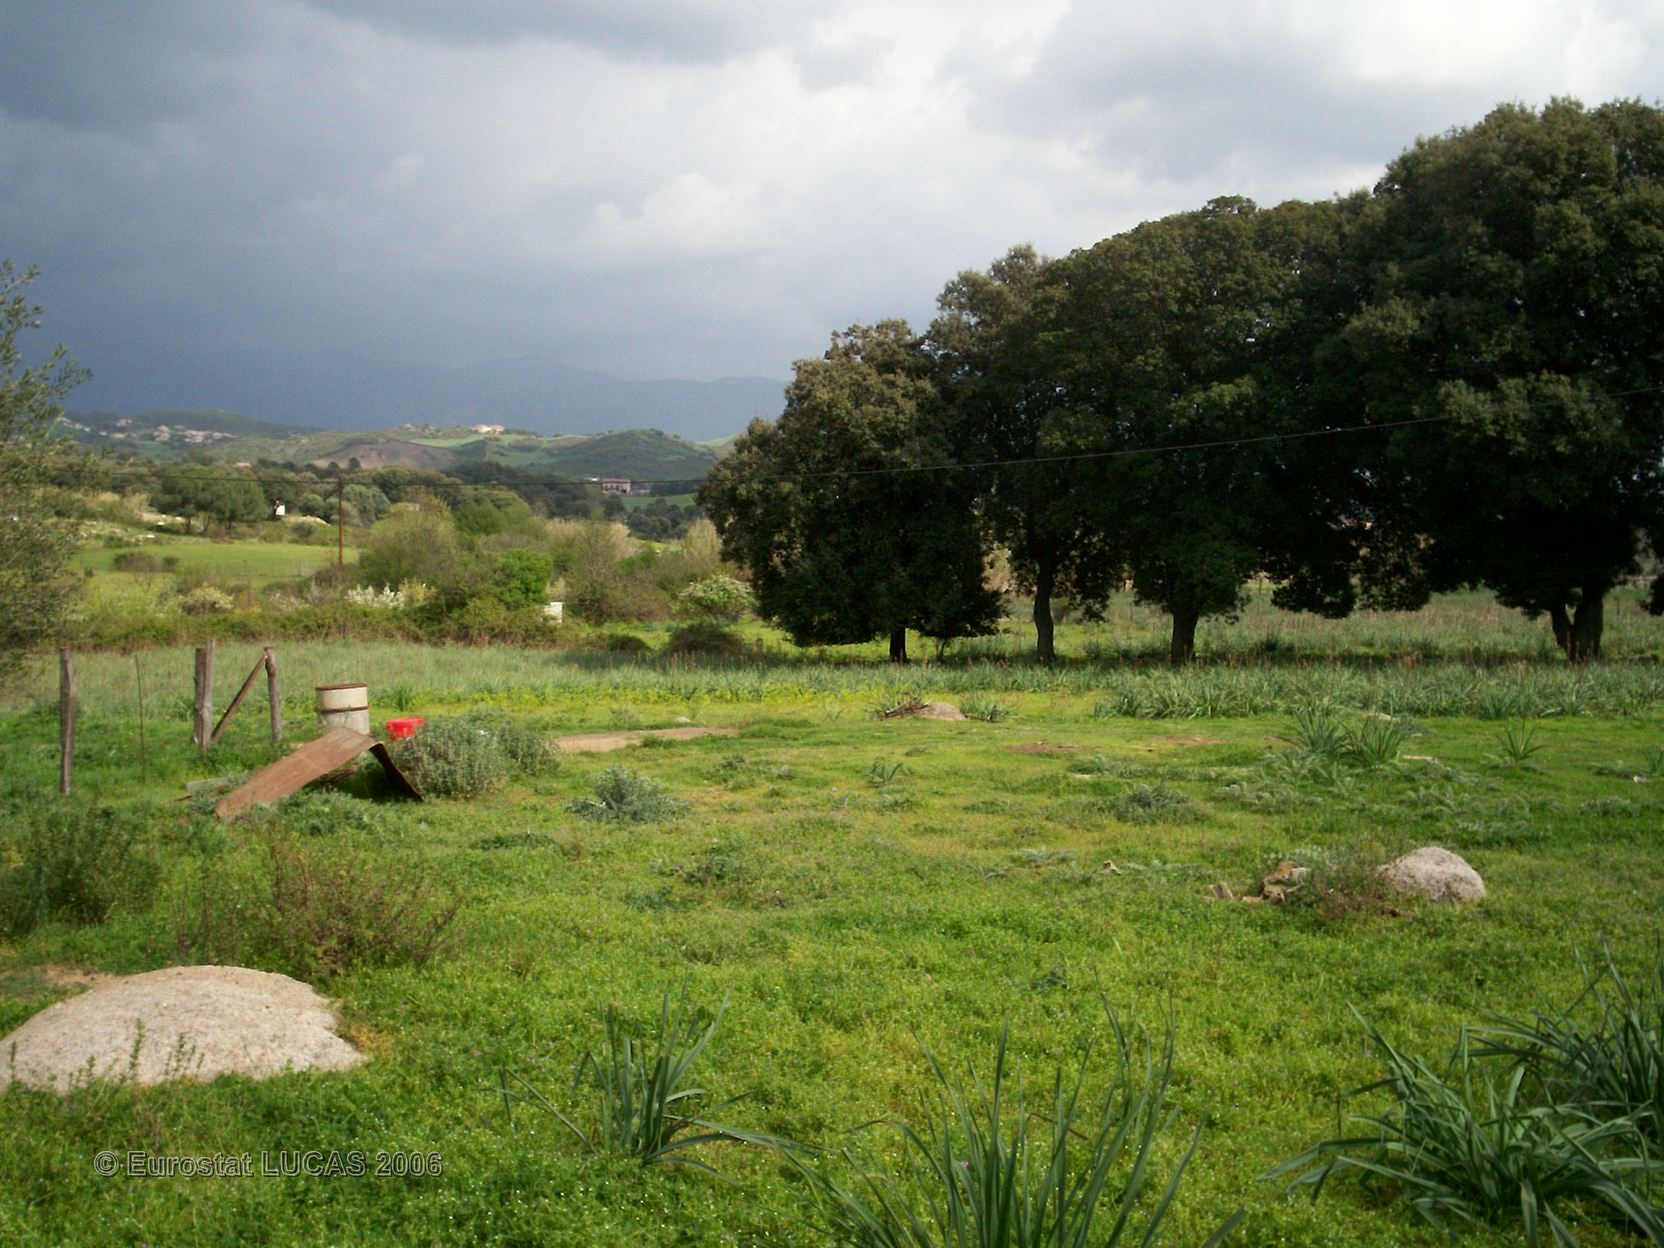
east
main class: Grassland
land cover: Grassland without tree/shrub cover
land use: Agriculture (excluding fallow land and kitchen gardens)
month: April
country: FR
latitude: 41.9960
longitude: 8.7613
